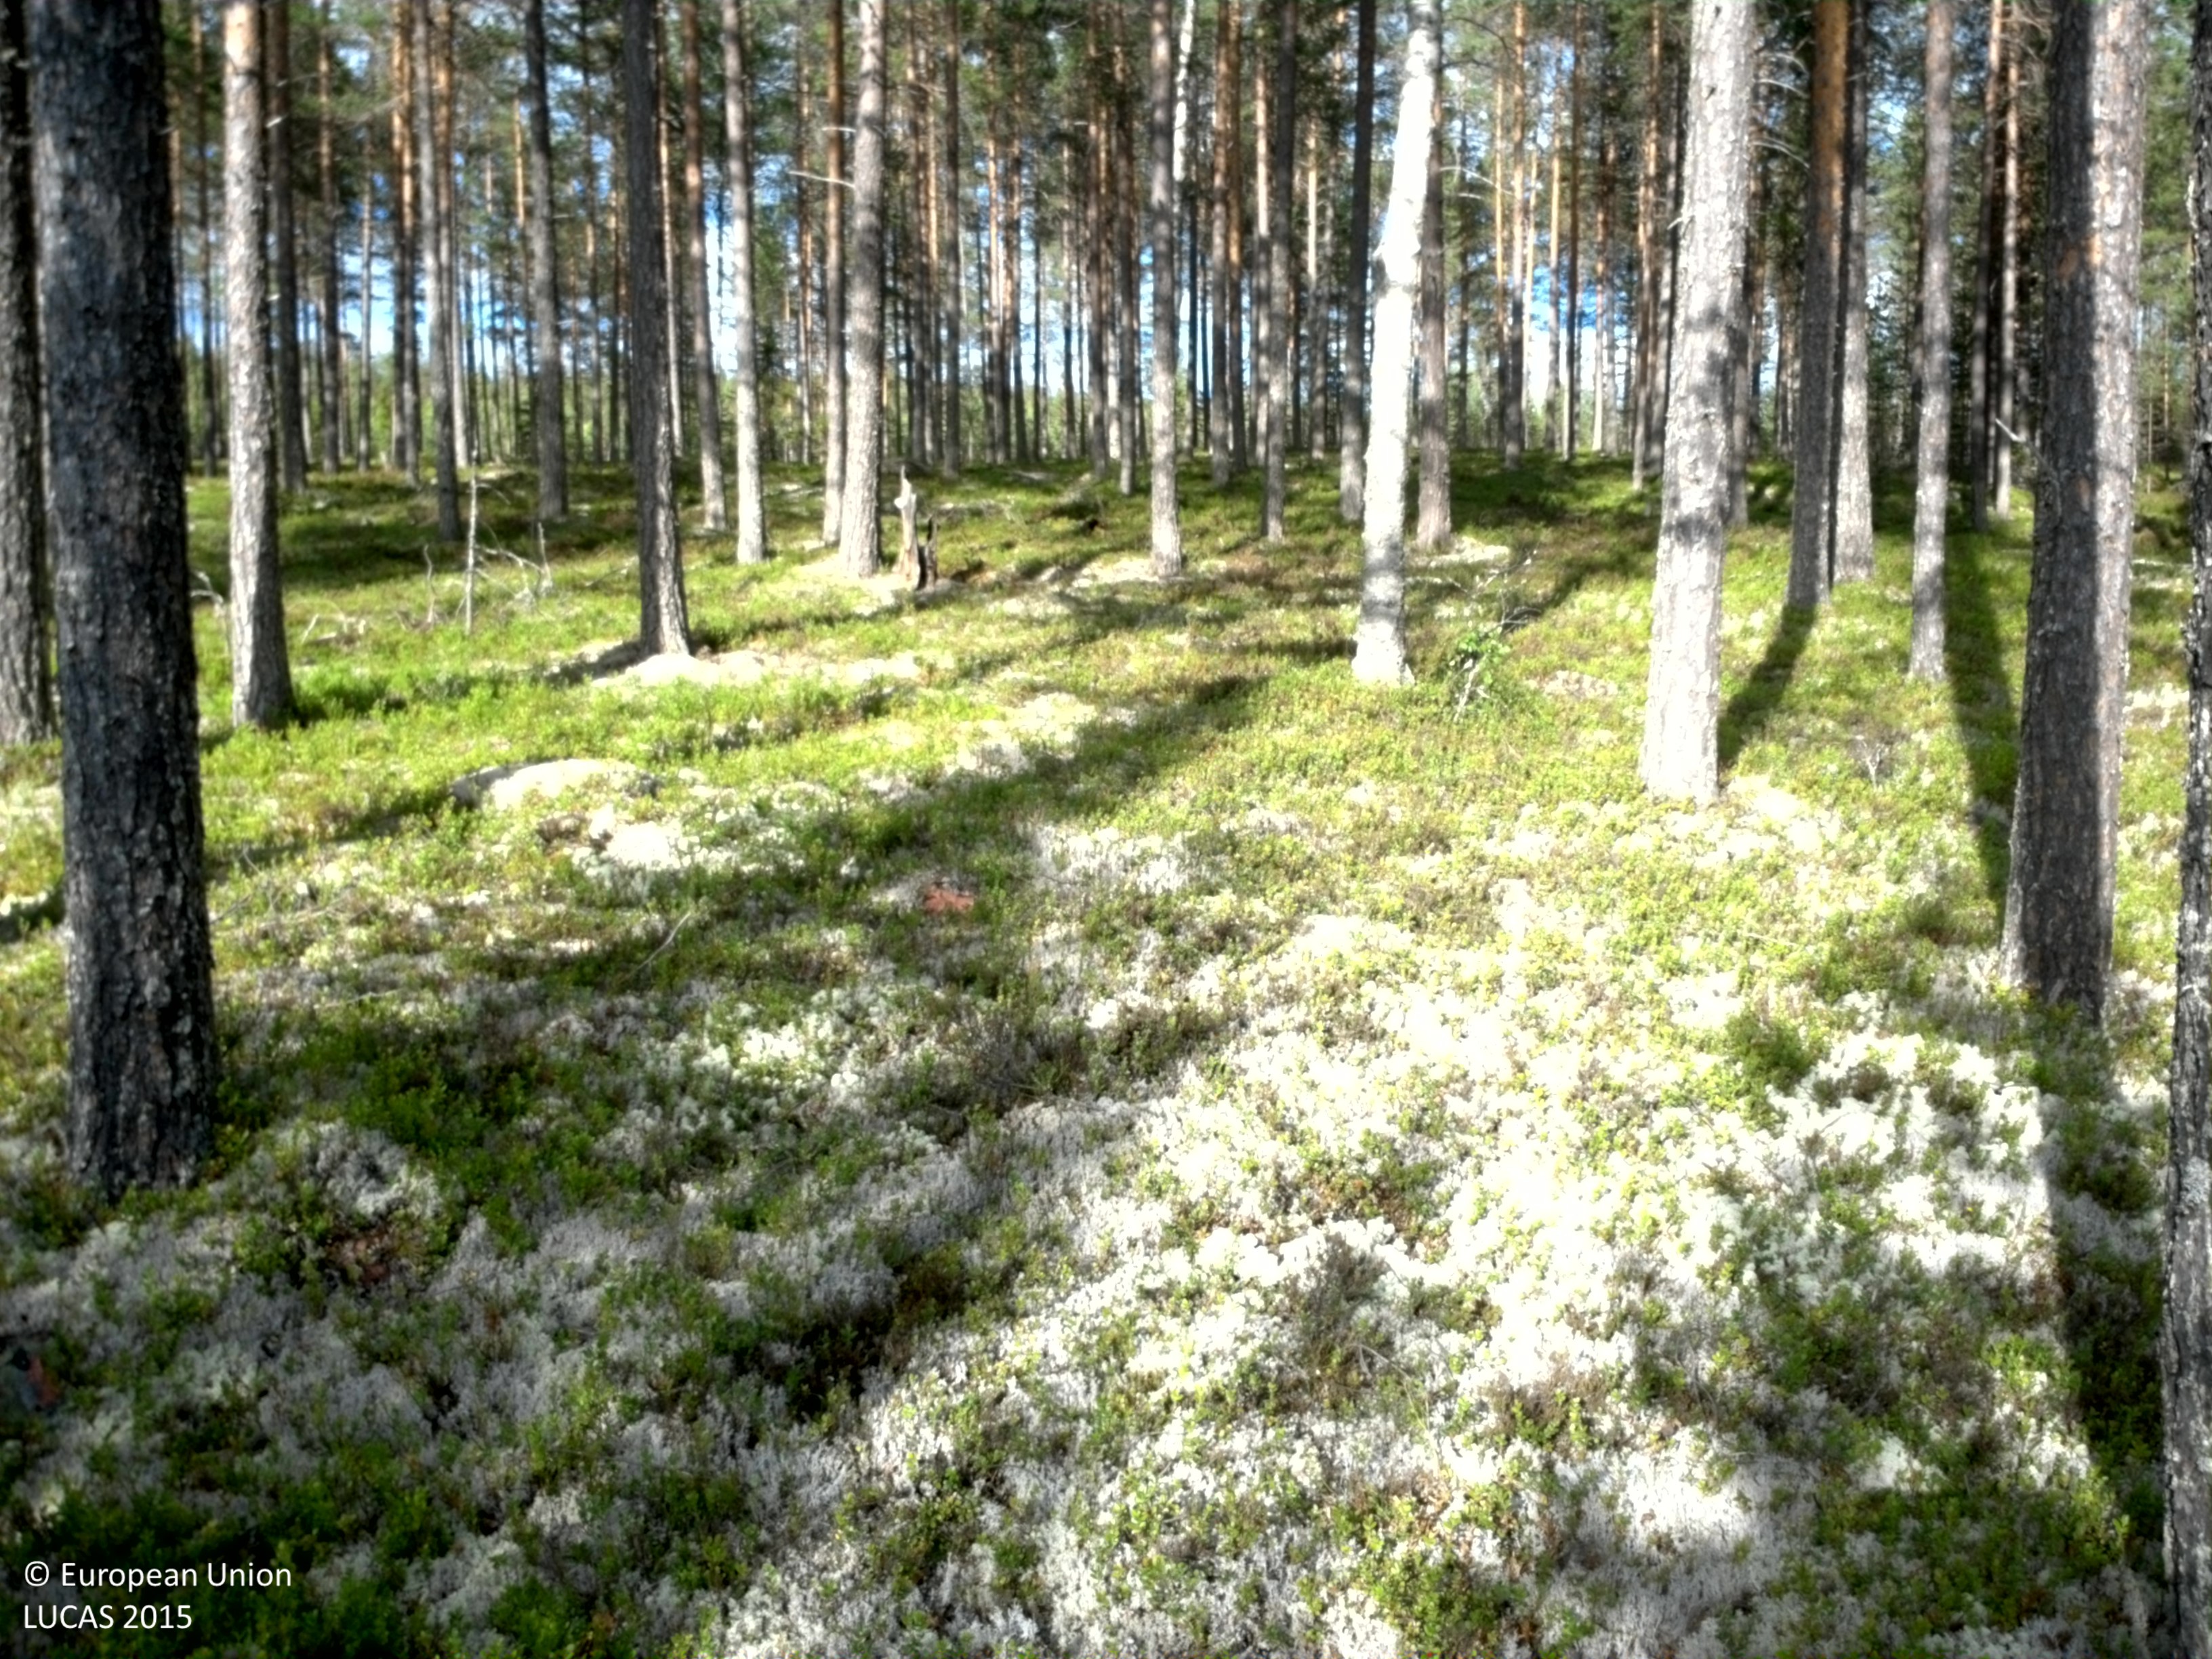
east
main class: Woodland
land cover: Pine dominated coniferous woodland
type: boreal forest
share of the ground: 50 - 75 %
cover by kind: coniferous forest trees 60 %, shrubs 15 %, lichens and mosses 15 %, broadleaved forest trees 10 %
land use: Forestry
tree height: > 5 m
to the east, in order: Pine dominated coniferous woodland
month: July
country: SE
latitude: 61.4847
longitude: 13.6860
